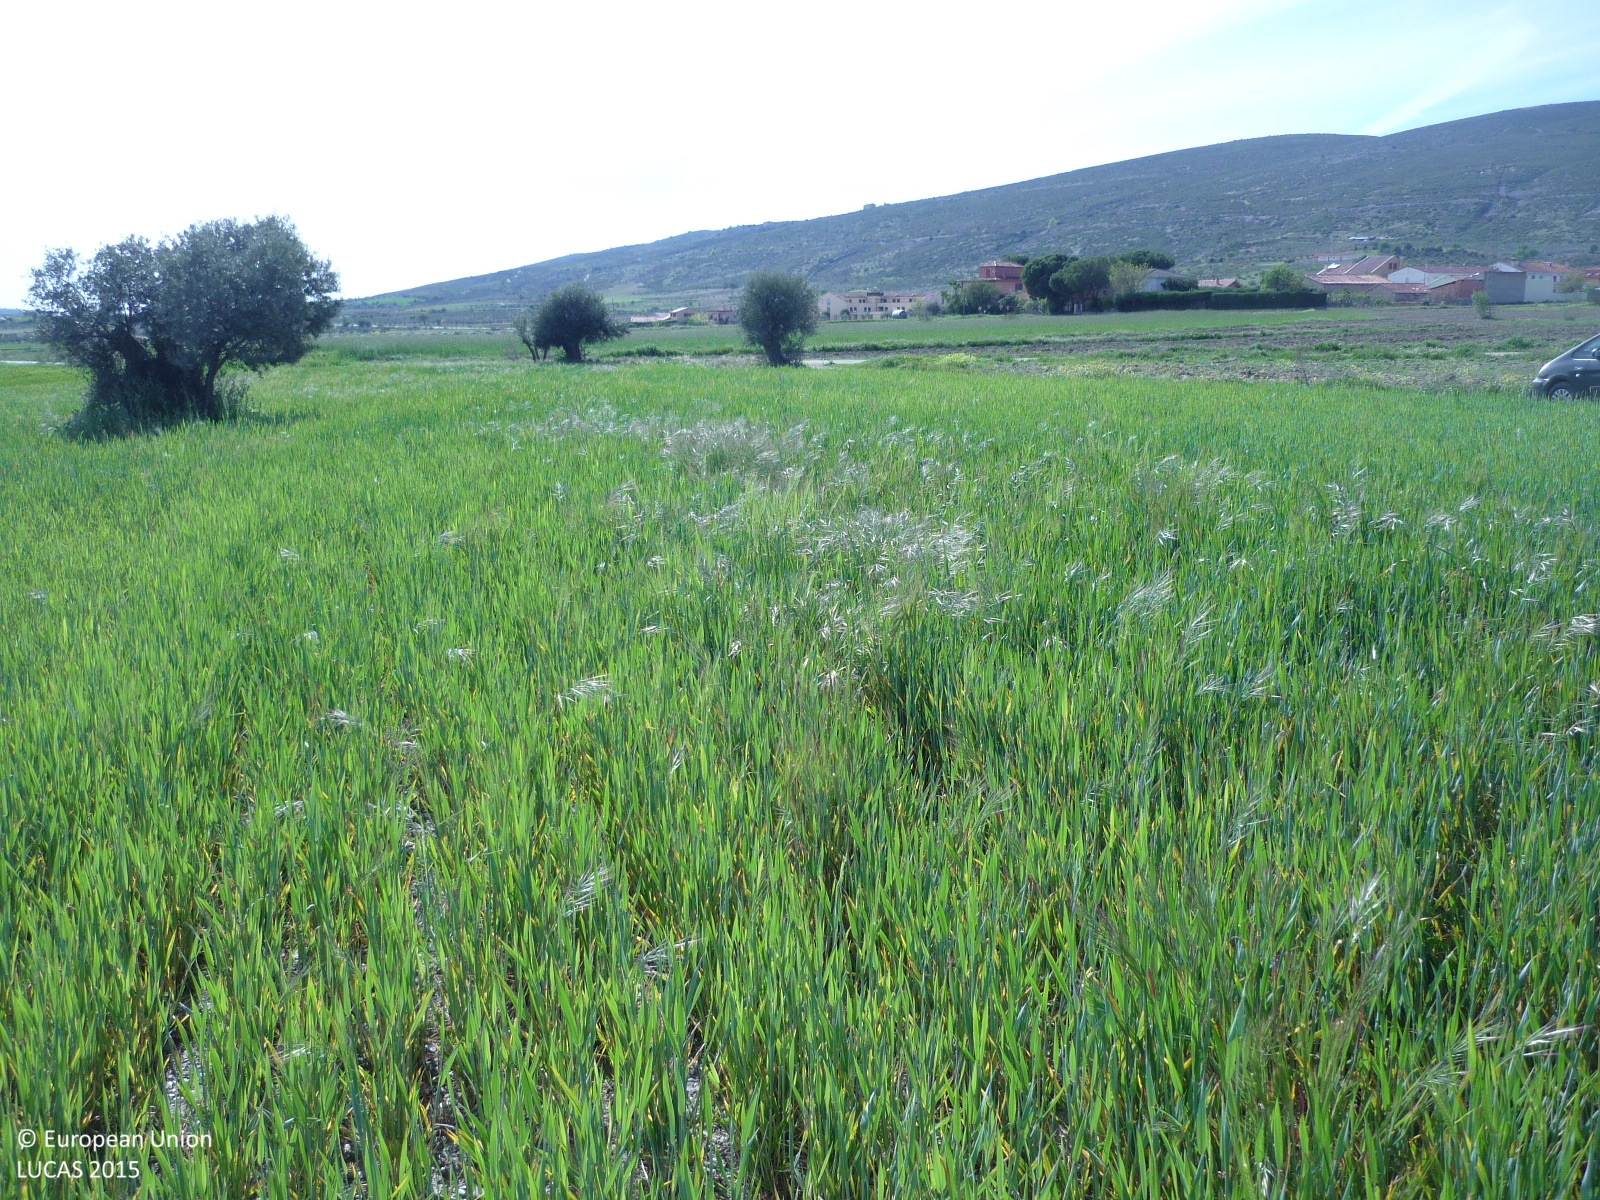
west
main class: Cropland
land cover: Common wheat
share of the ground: > 75 %
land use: Agriculture (excluding fallow land and kitchen gardens)
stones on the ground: < 10 %
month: April
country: ES
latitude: 40.8520
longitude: -3.4797
